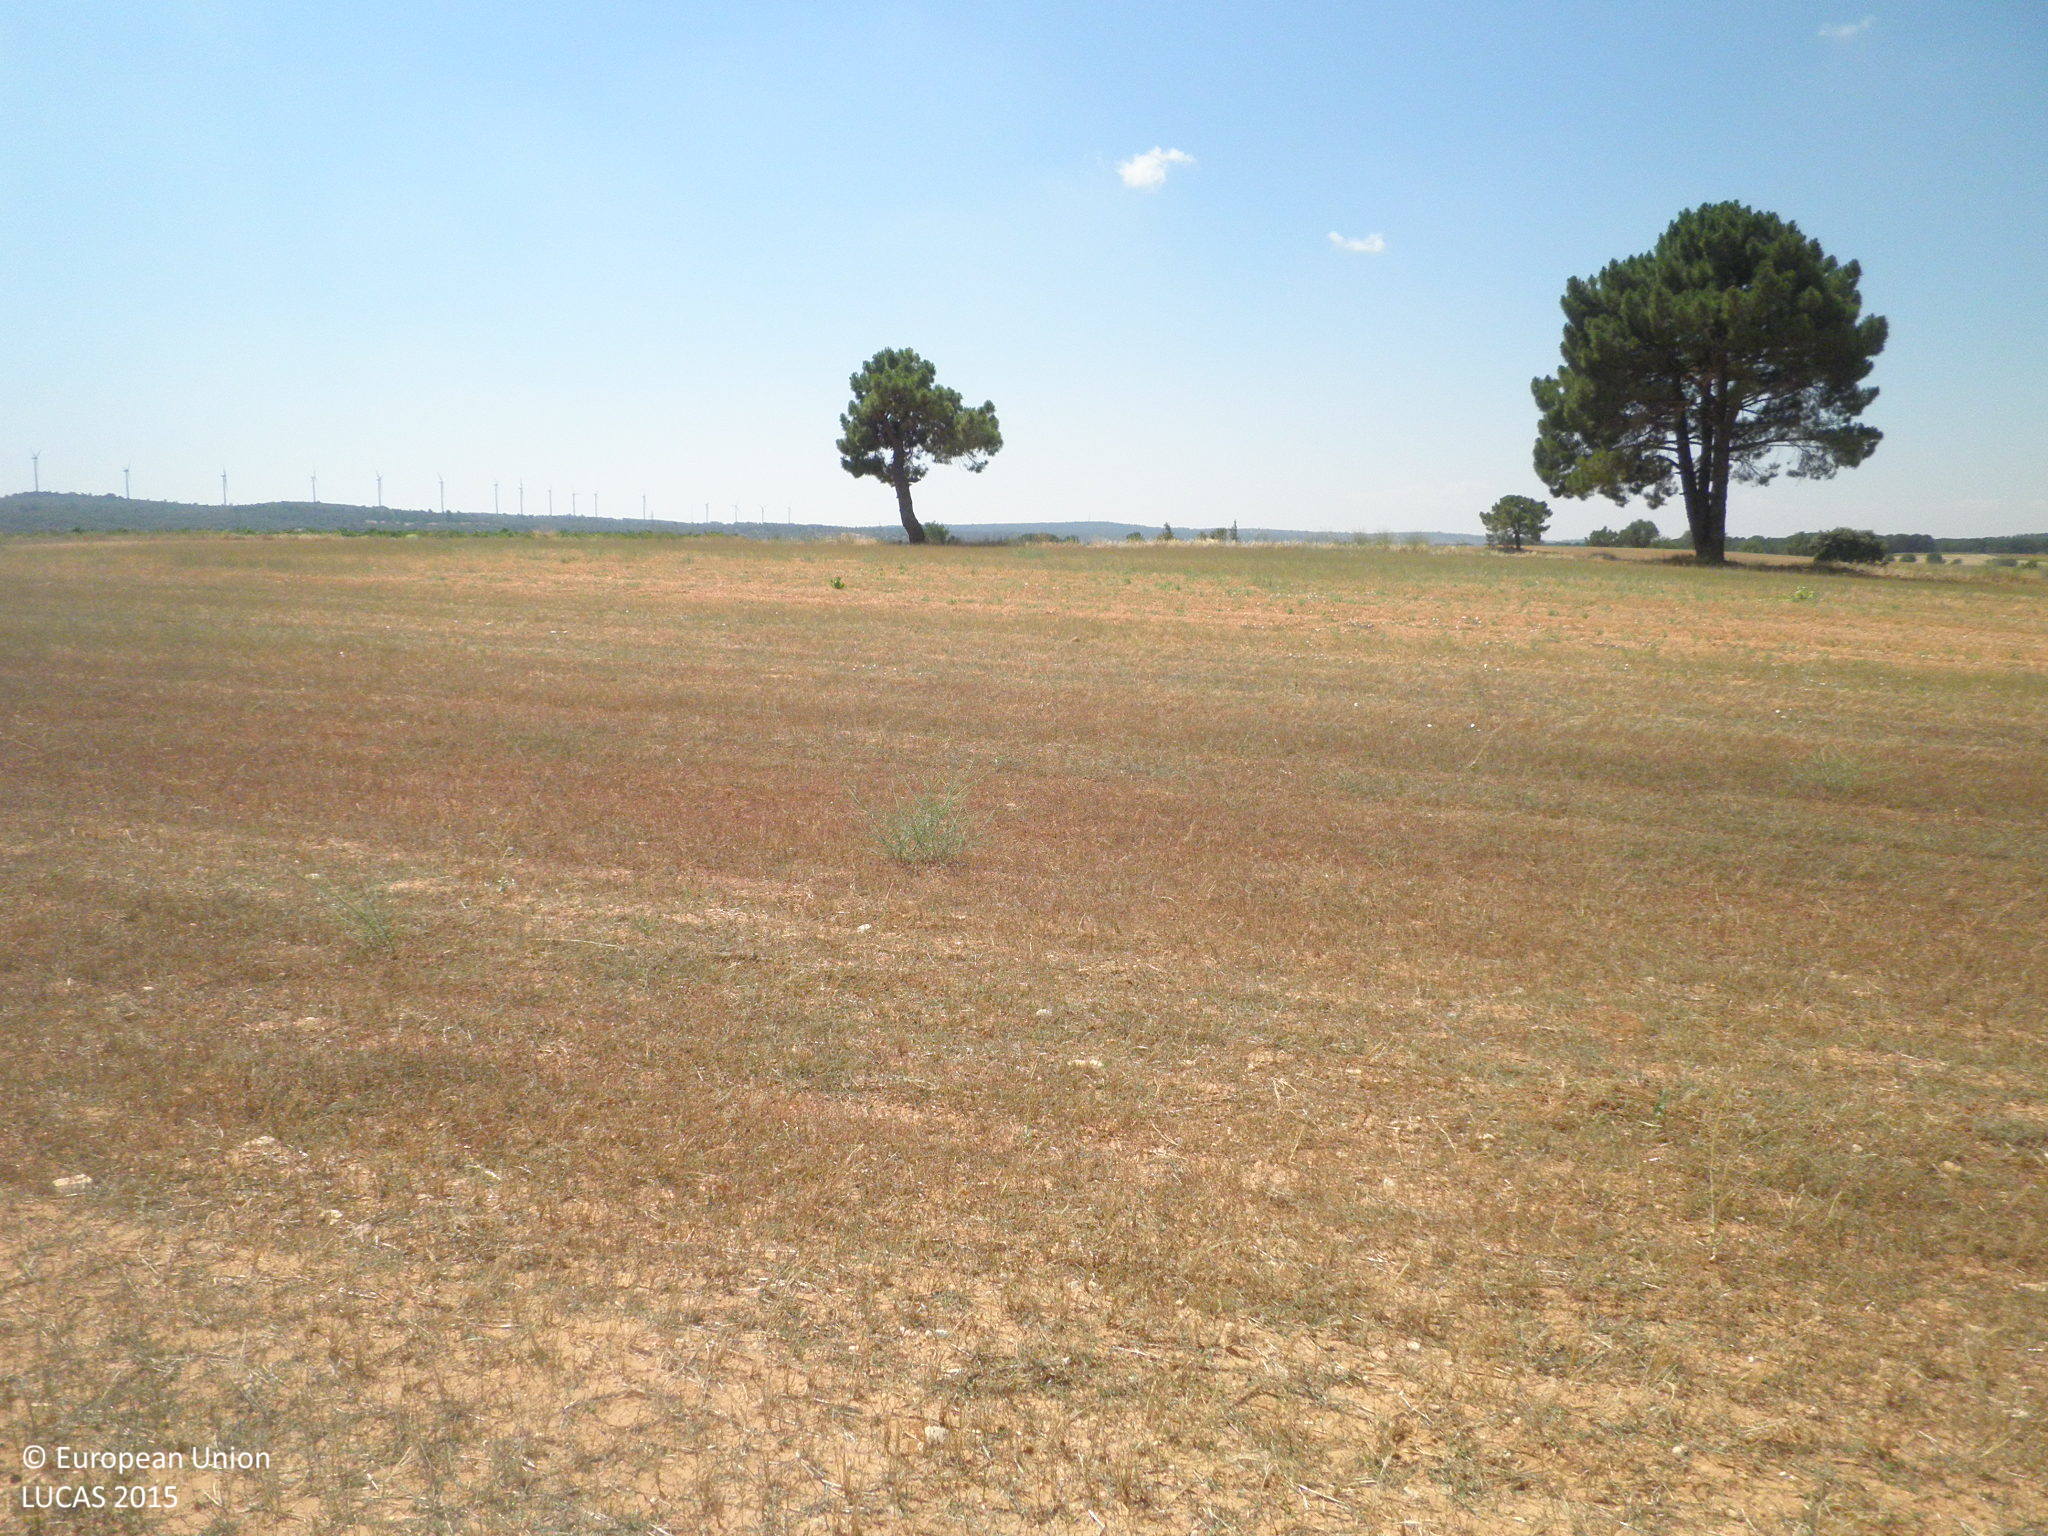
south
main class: Cropland
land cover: Dry pulses
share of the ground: < 10 %
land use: Agriculture (excluding fallow land and kitchen gardens)
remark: Harvested field
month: July
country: ES
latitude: 39.6659
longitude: -1.7695
